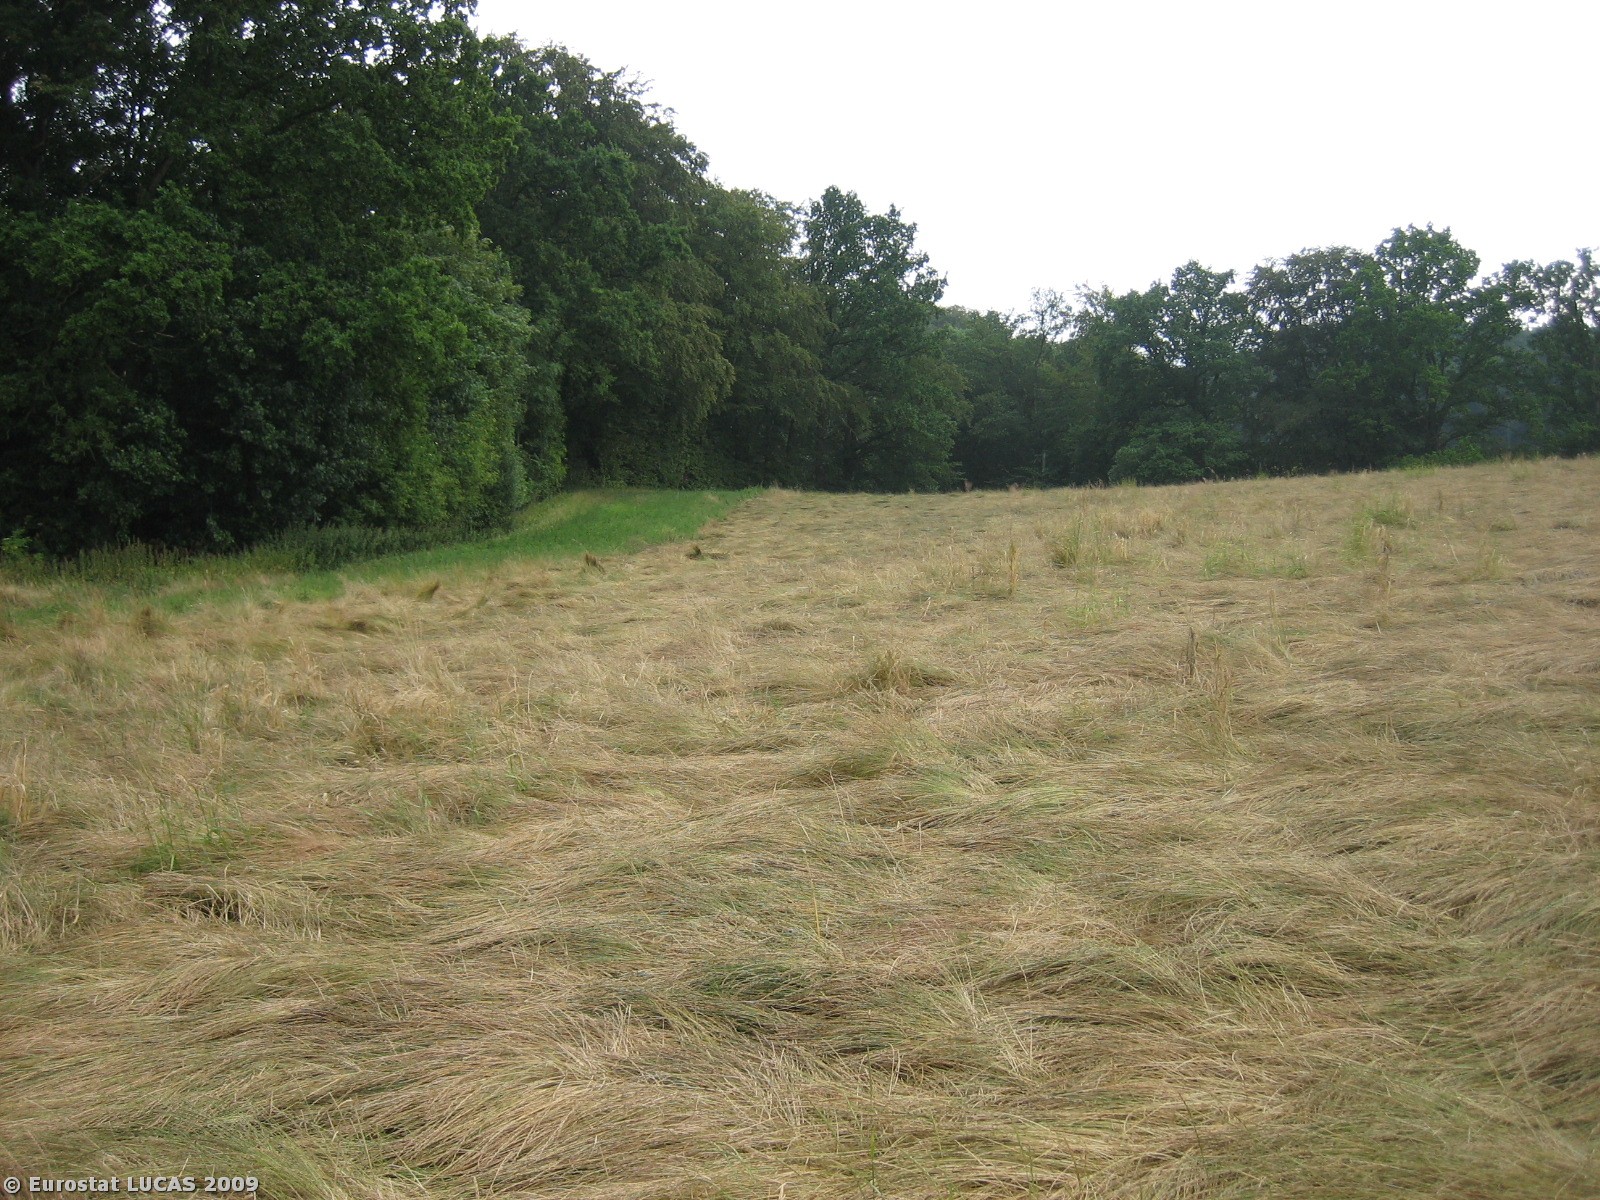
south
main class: Cropland
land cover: Temporary grasslands
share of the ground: > 75 %
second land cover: Barley
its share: < 10 %
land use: Agriculture (excluding fallow land and kitchen gardens)
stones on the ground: < 10 %
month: July
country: DK
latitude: 55.3789
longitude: 9.9842
